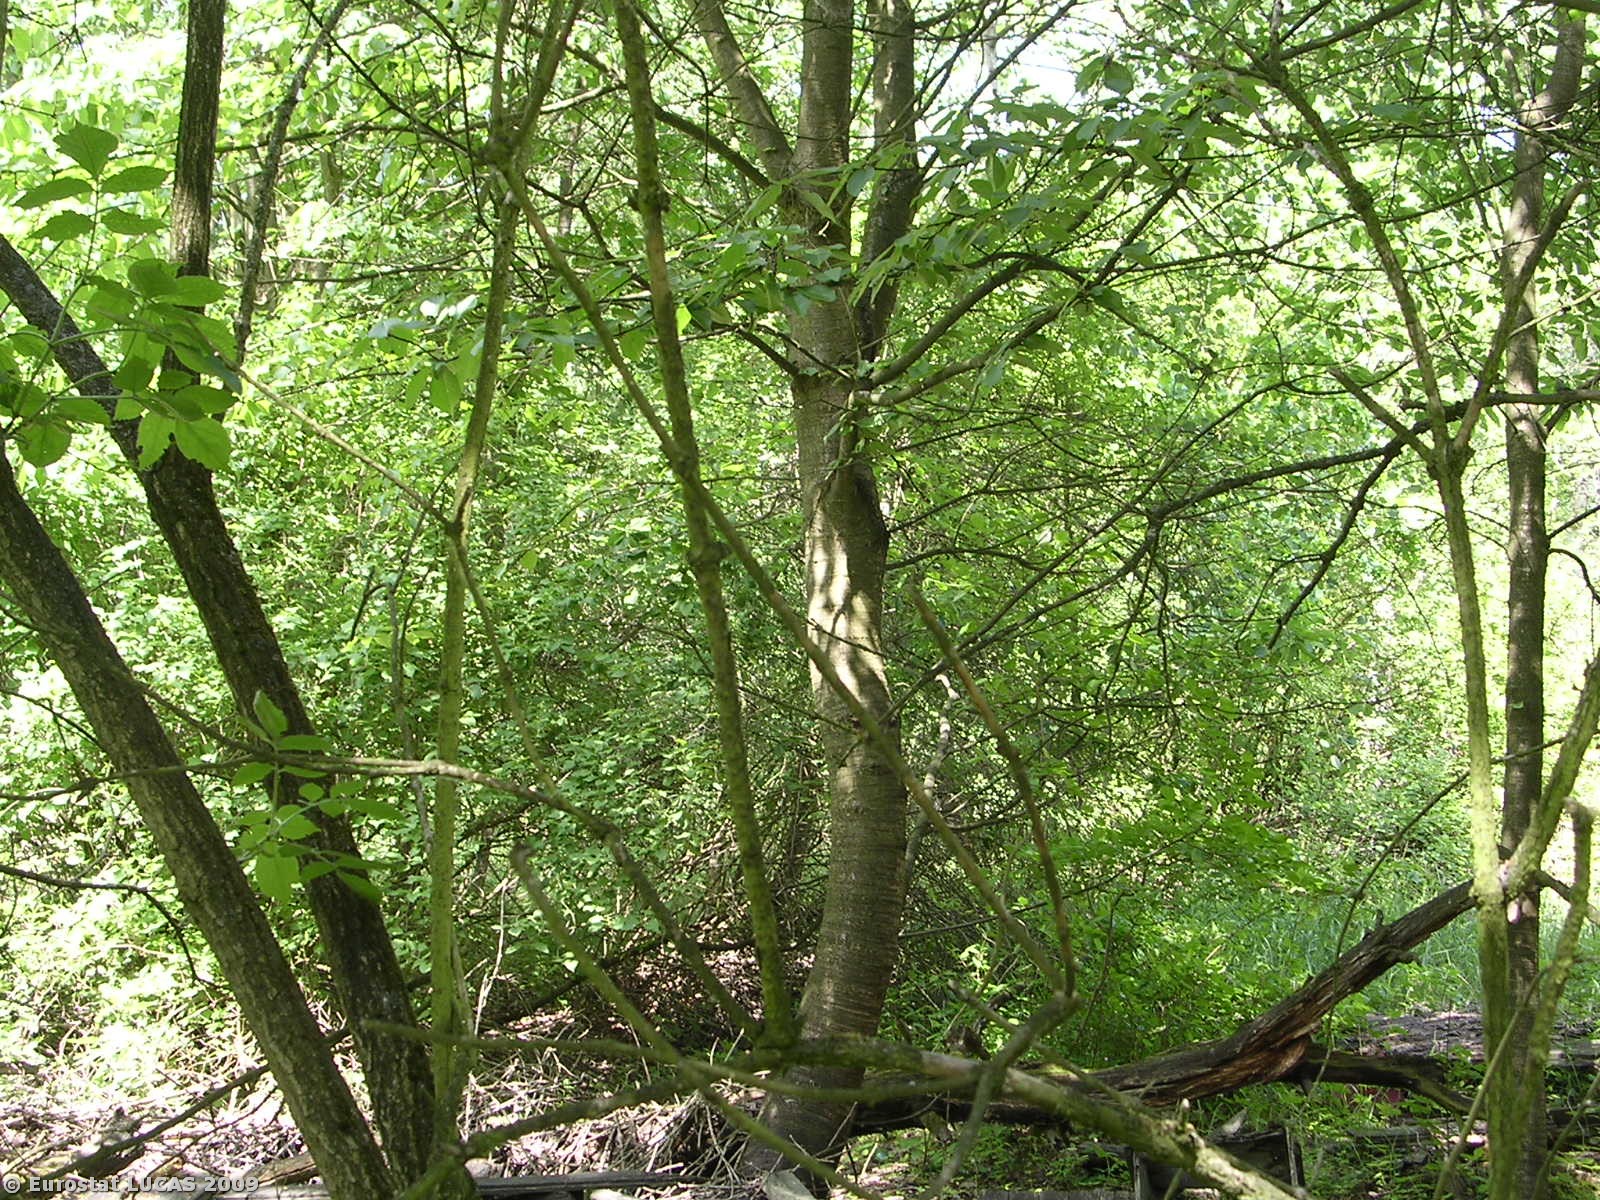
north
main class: Woodland
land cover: Broadleaved woodland
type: hemiboreal forest and nemoral coniferous forest and mixed broadleaved-coniferous forest
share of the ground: > 75 %
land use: Unused
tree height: > 5 m
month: May
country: CZ
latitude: 50.2400
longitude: 14.9241
